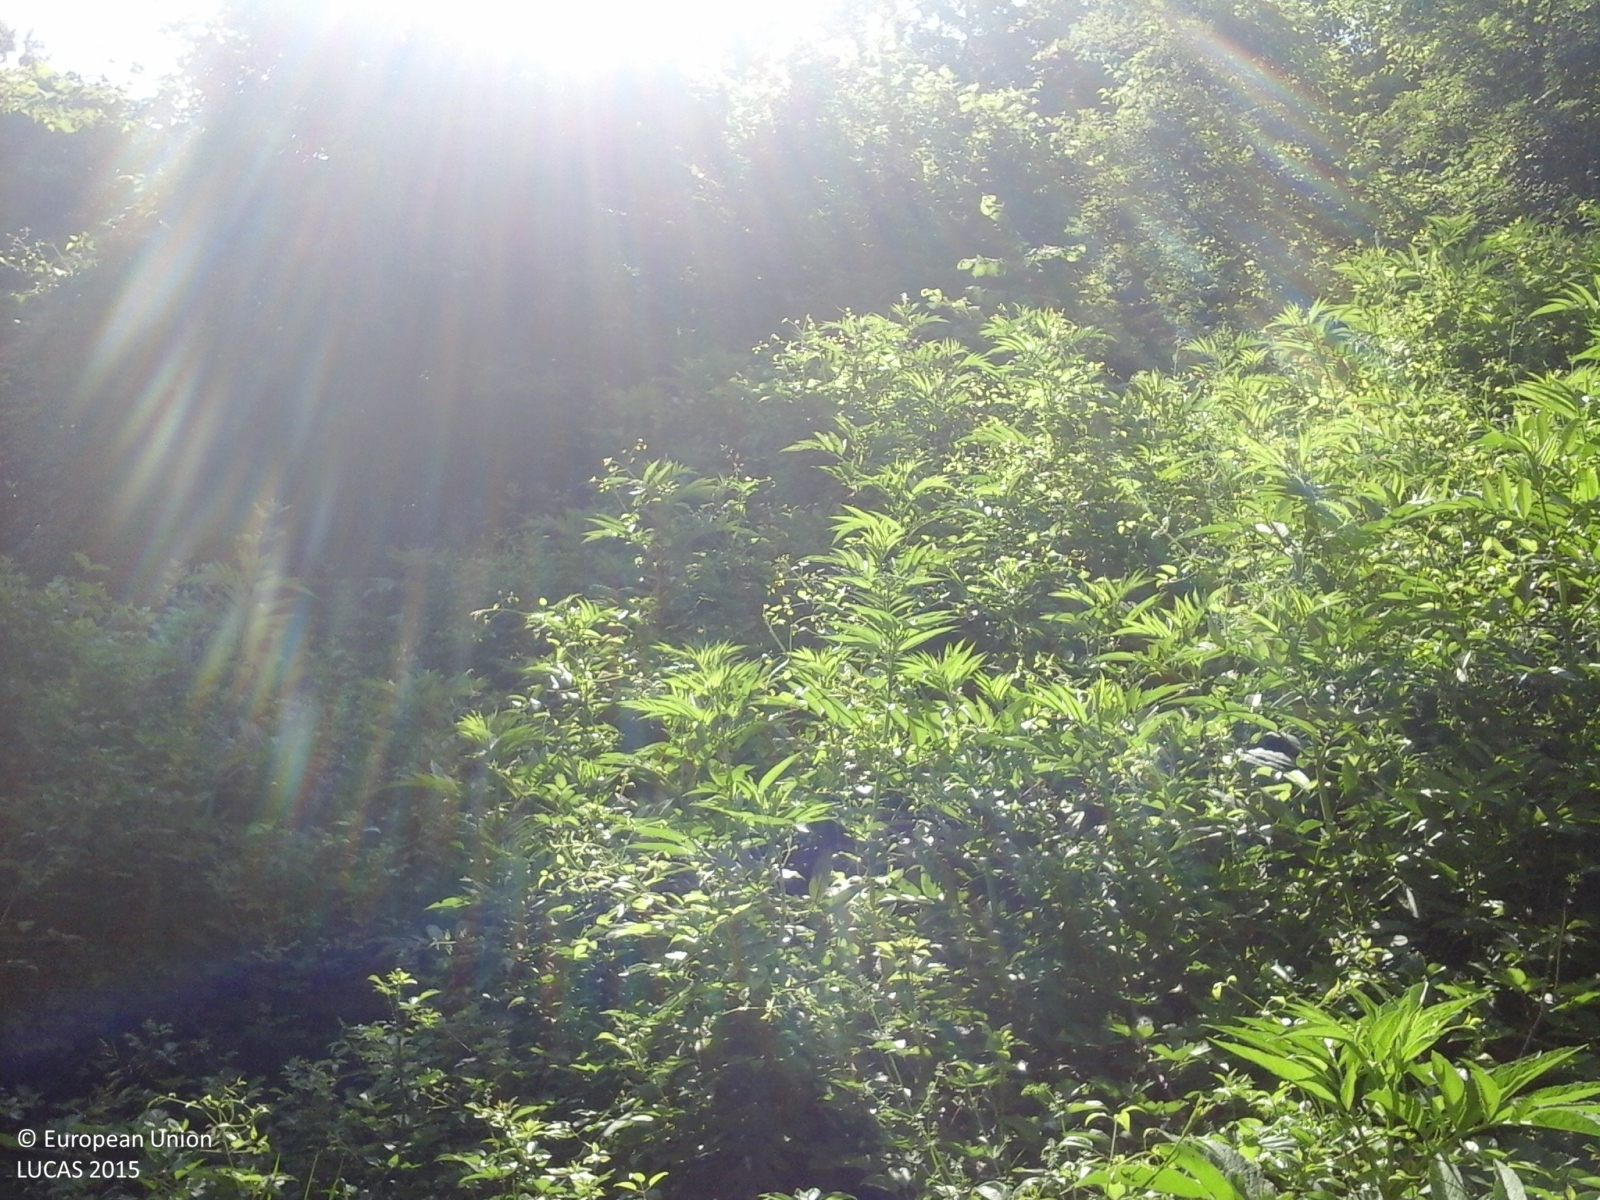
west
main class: Grassland
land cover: Grassland without tree/shrub cover
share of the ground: > 75 %
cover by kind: herbaceous plants 100 %
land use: Semi-natural and natural areas not in use
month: June
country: IT
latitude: 44.3306
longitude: 10.6381
